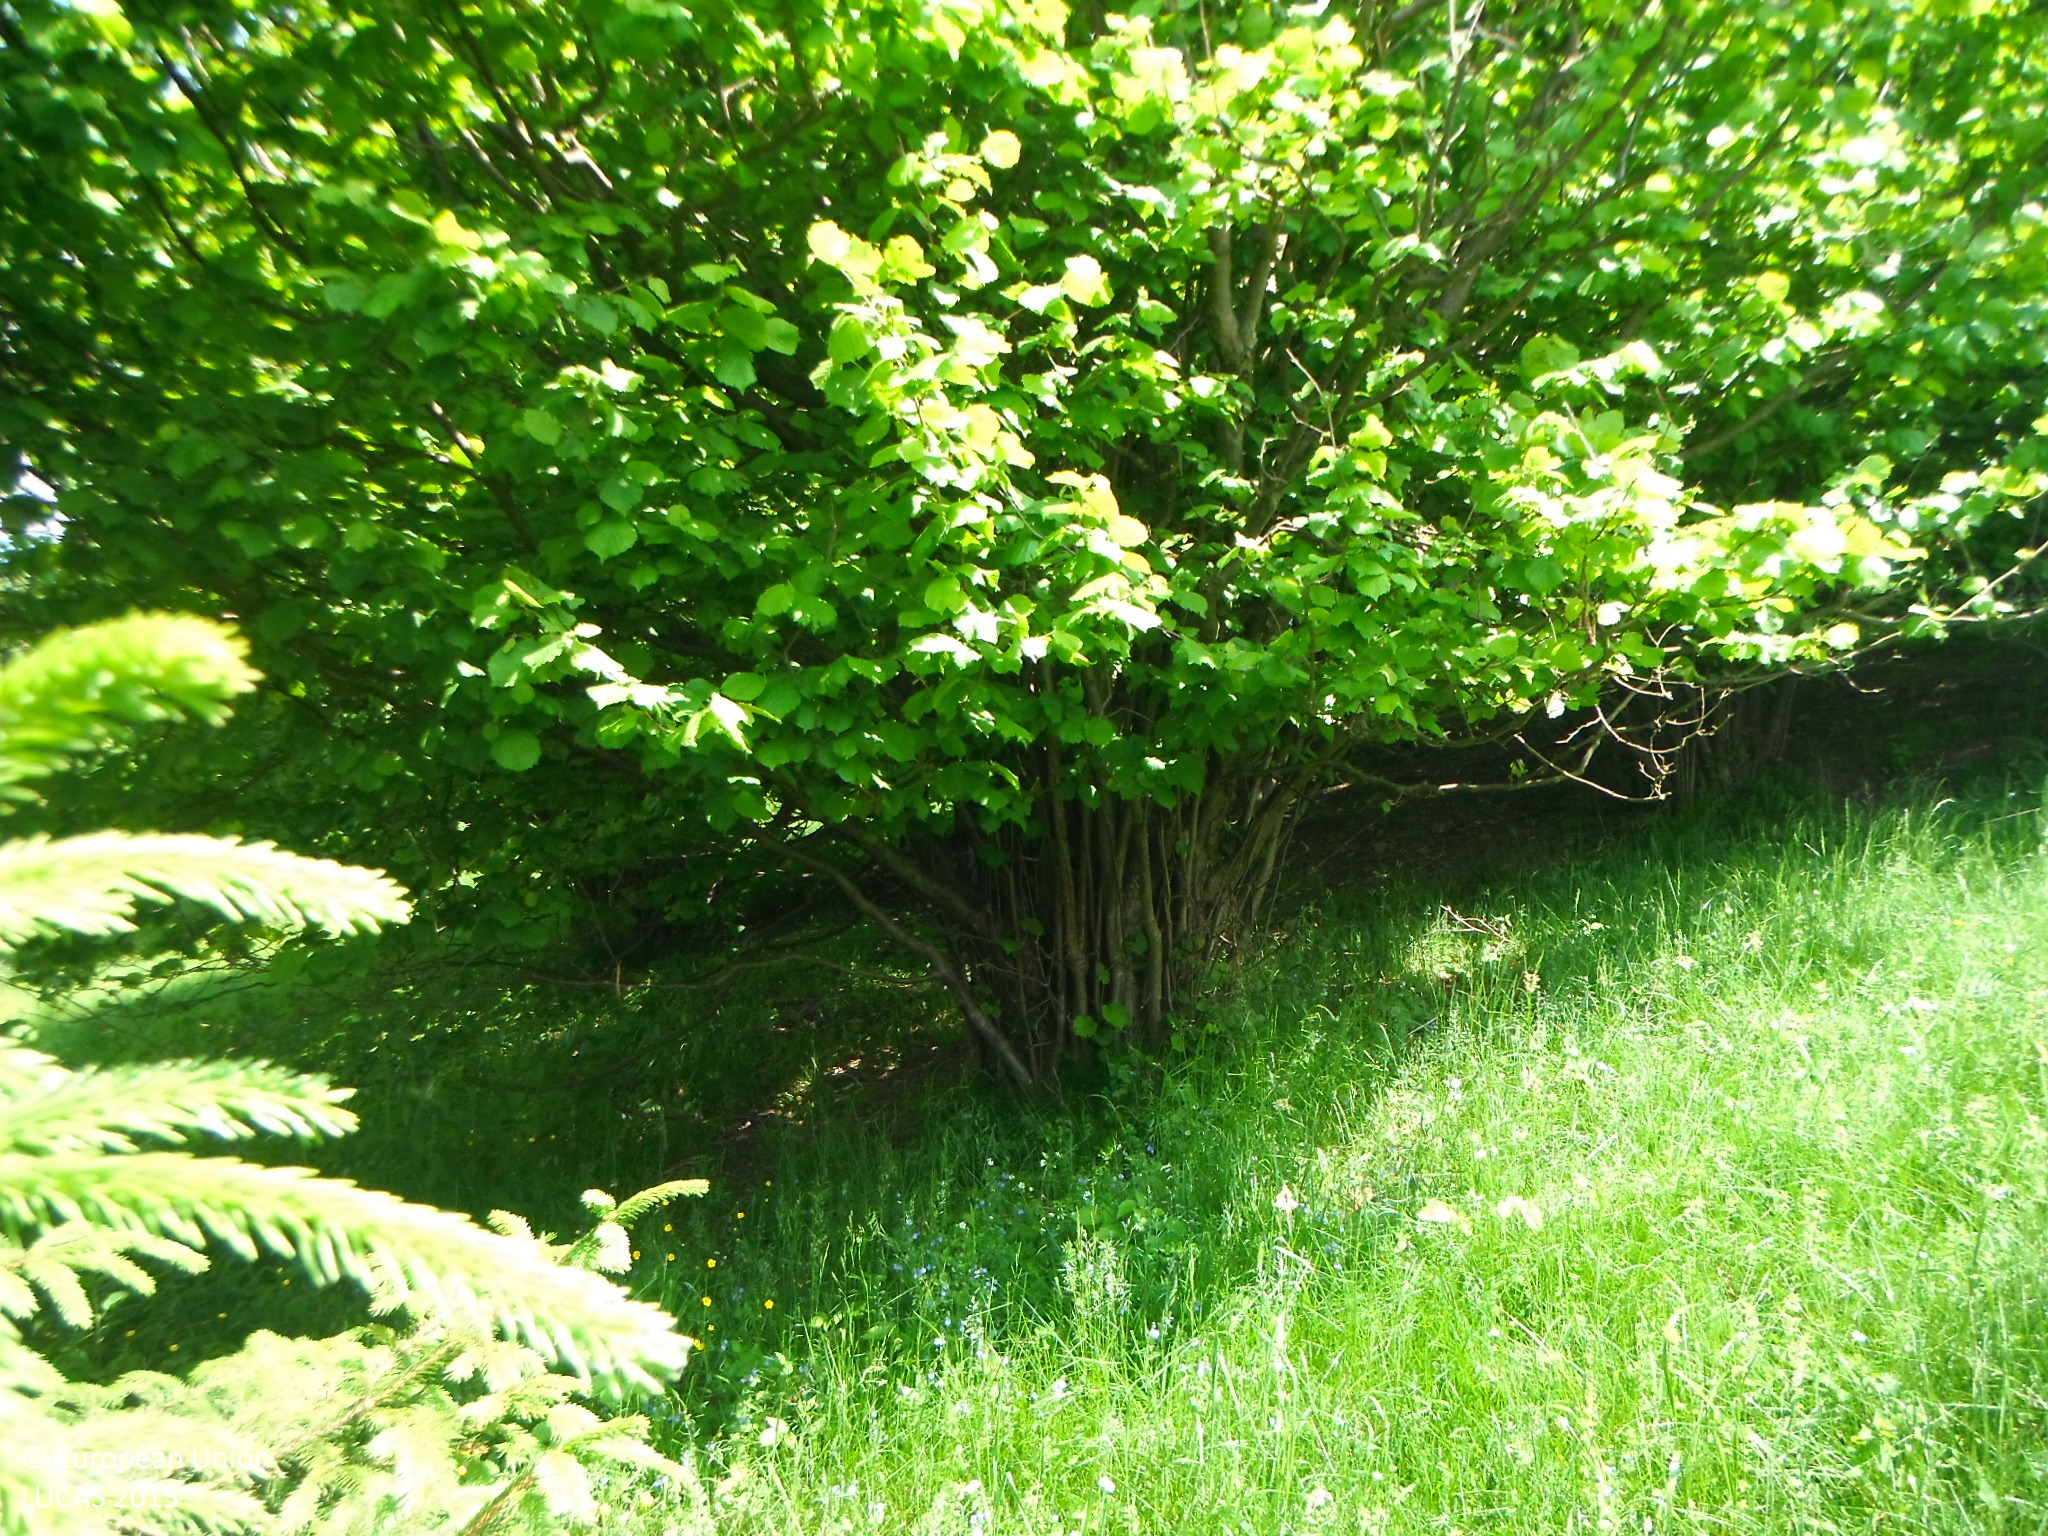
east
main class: Woodland
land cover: Spruce dominated mixed woodland
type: hemiboreal forest and nemoral coniferous forest and mixed broadleaved-coniferous forest
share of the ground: 25 - 50 %
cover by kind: herbaceous plants 60 %, coniferous forest trees 20 %, broadleaved forest trees 20 %
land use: Agriculture (excluding fallow land and kitchen gardens)
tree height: > 5 m
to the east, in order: Spruce dominated mixed woodland; Grassland without tree/shrub cover; Grassland with sparse tree/shrub cover
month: June
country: SK
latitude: 49.2887
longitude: 20.4159
